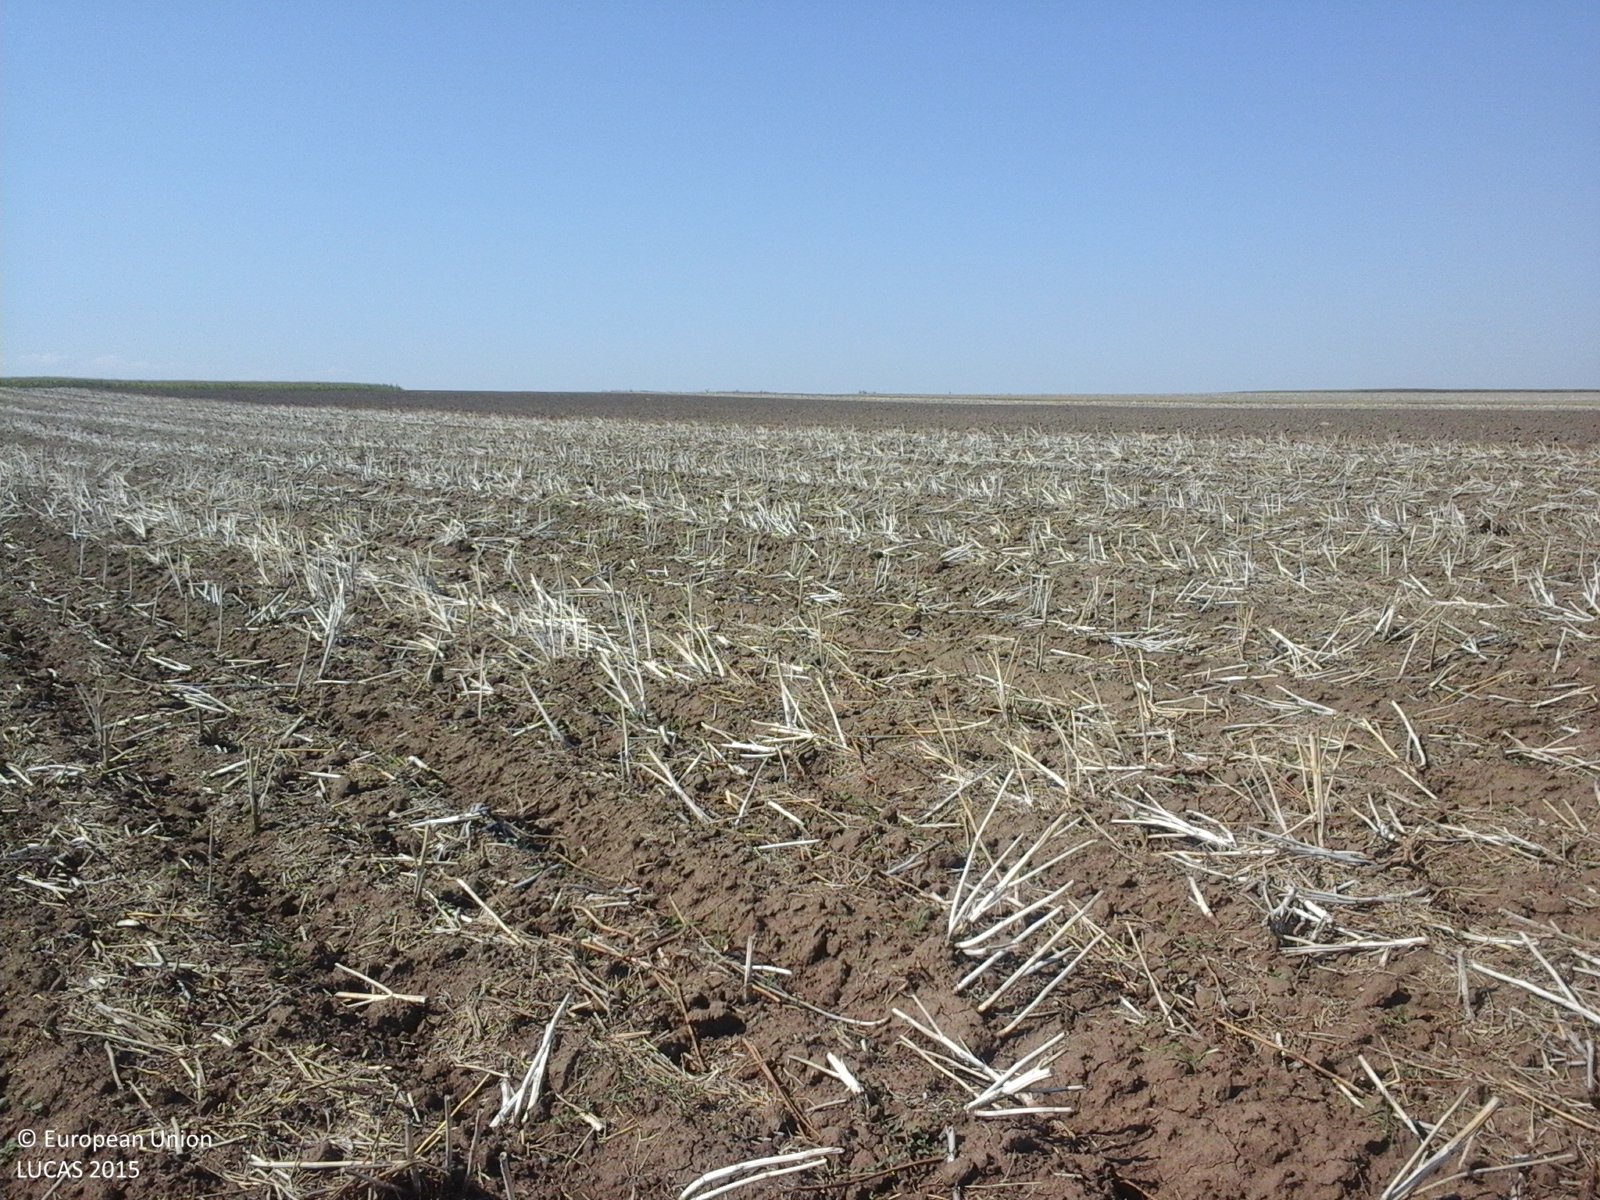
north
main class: Cropland
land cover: Rape and turnip rape
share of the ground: 10 - 25 %
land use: Agriculture (excluding fallow land and kitchen gardens)
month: August
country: RO
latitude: 44.2540
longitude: 28.4161
